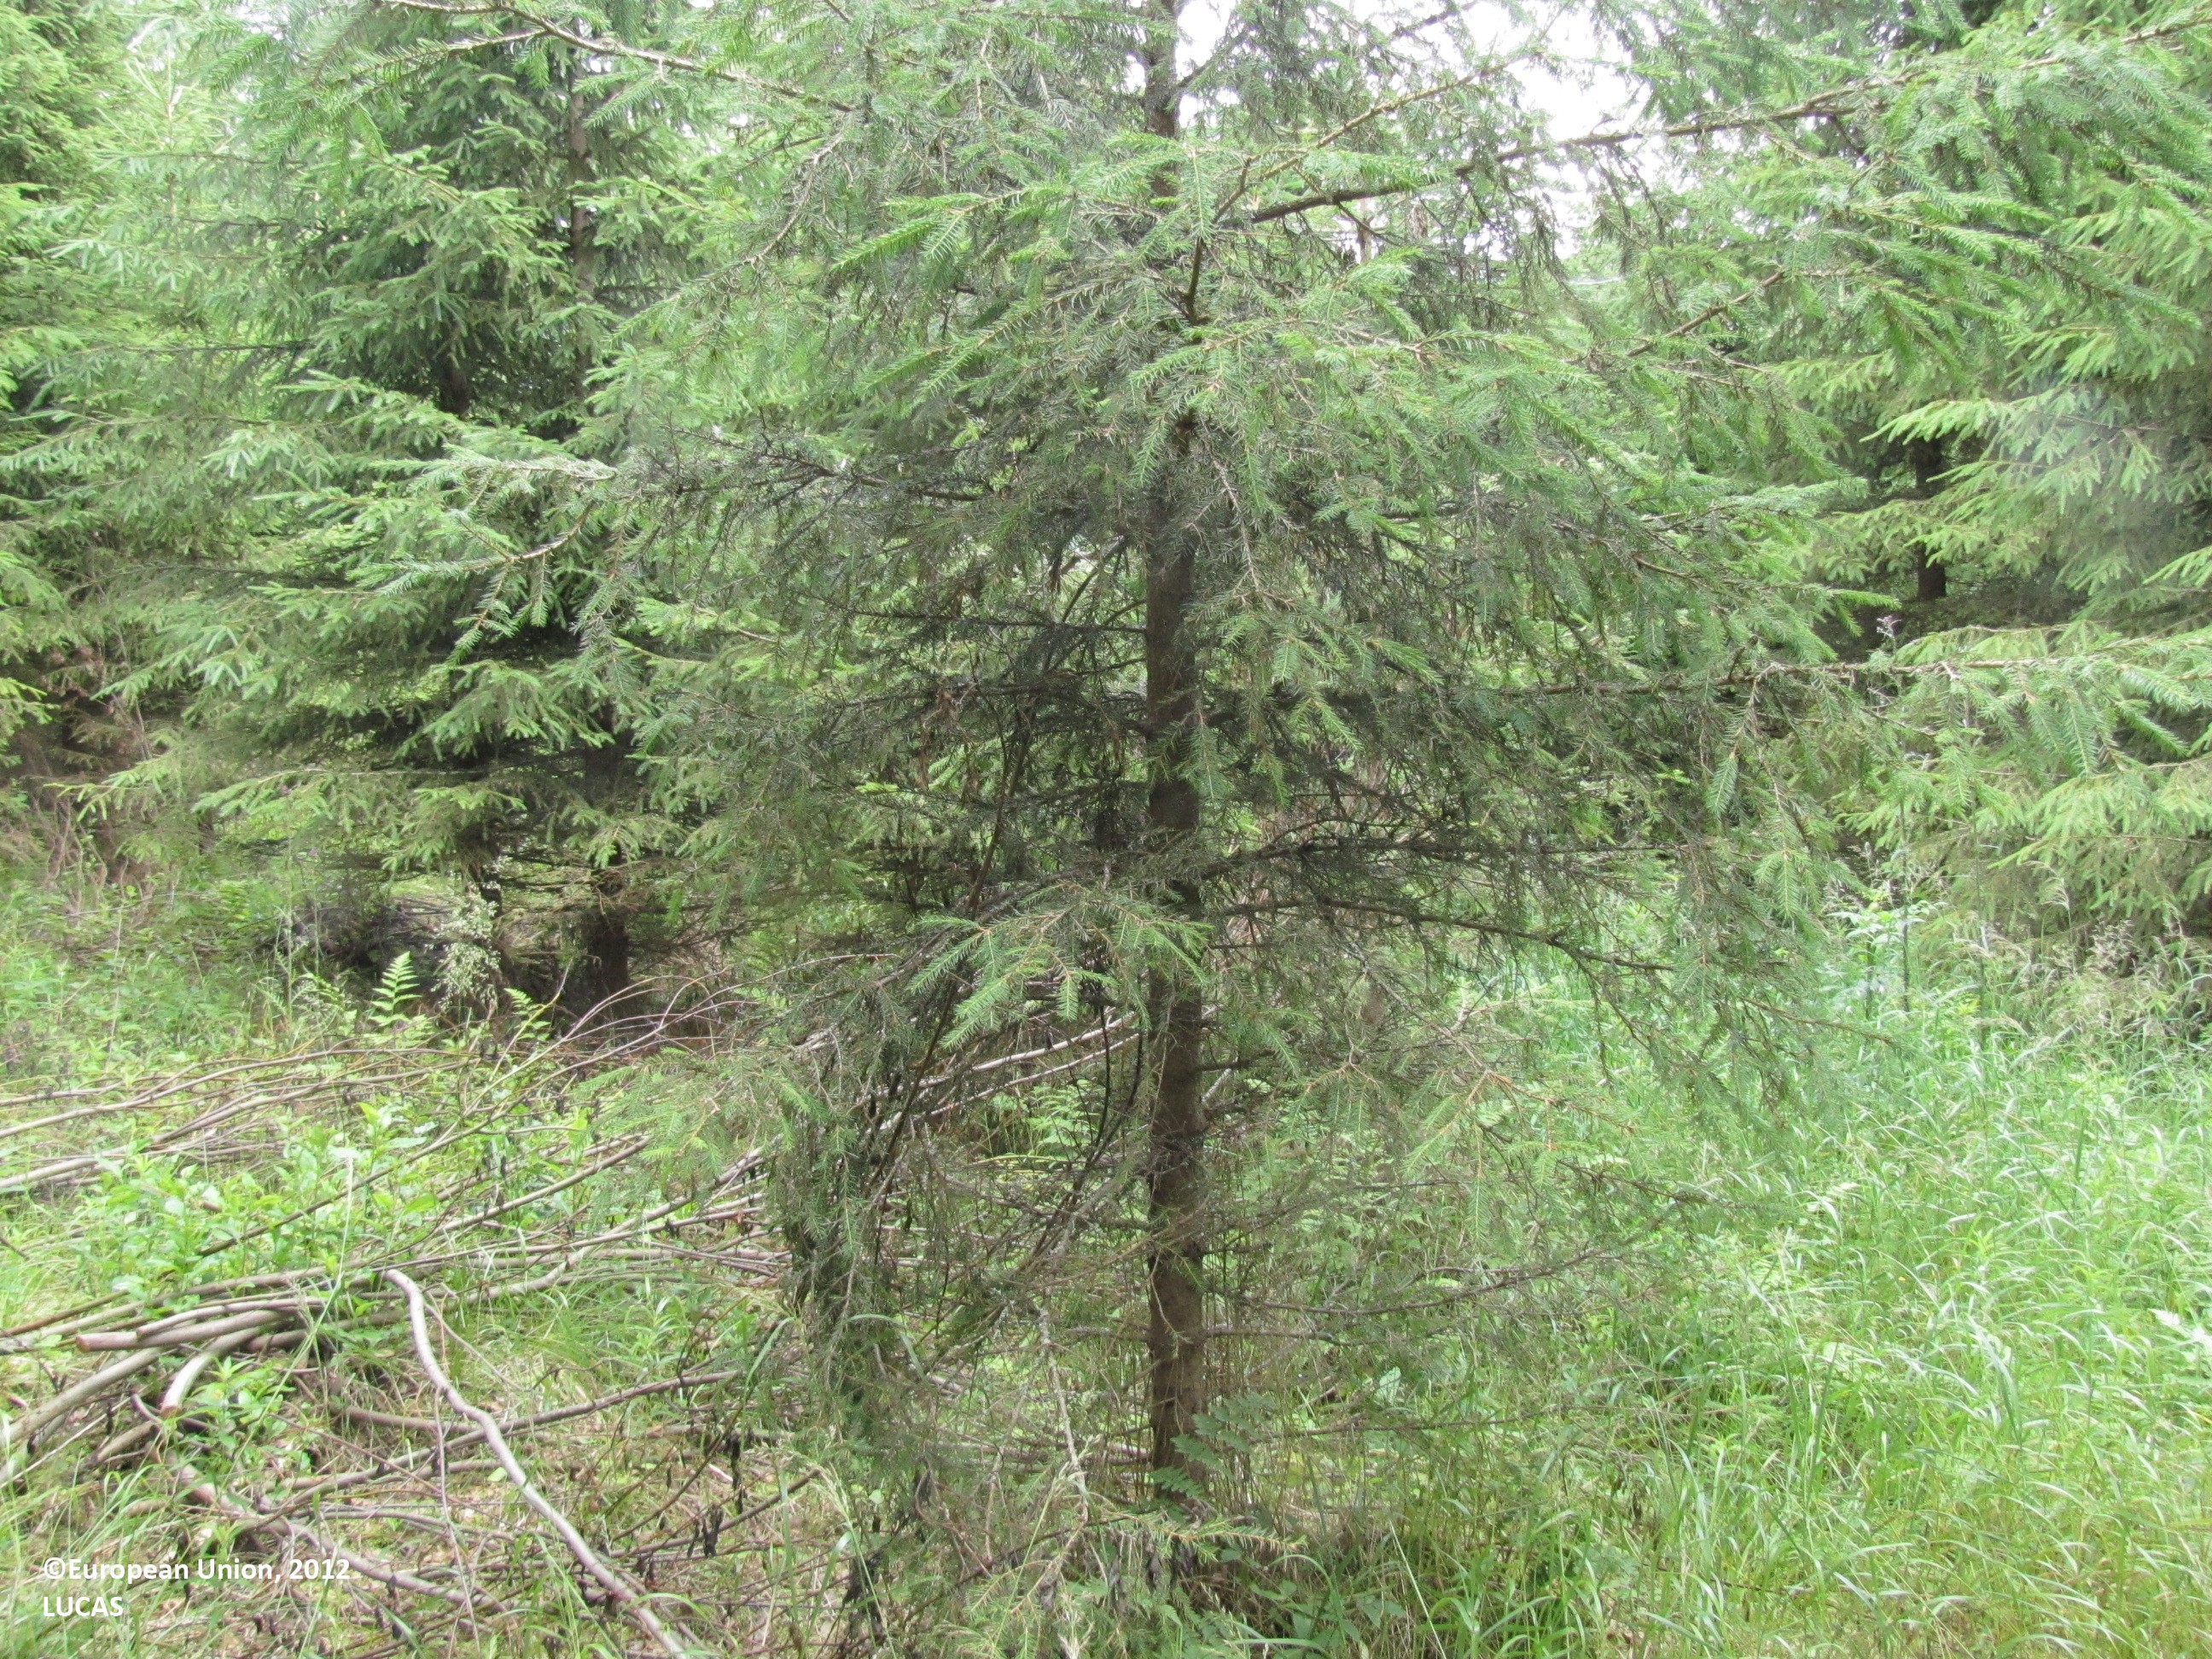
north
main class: Woodland
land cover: Spruce dominated coniferous woodland
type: boreal forest
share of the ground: > 75 %
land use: Forestry
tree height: > 5 m
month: July
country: FI
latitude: 62.6876
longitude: 23.4106
